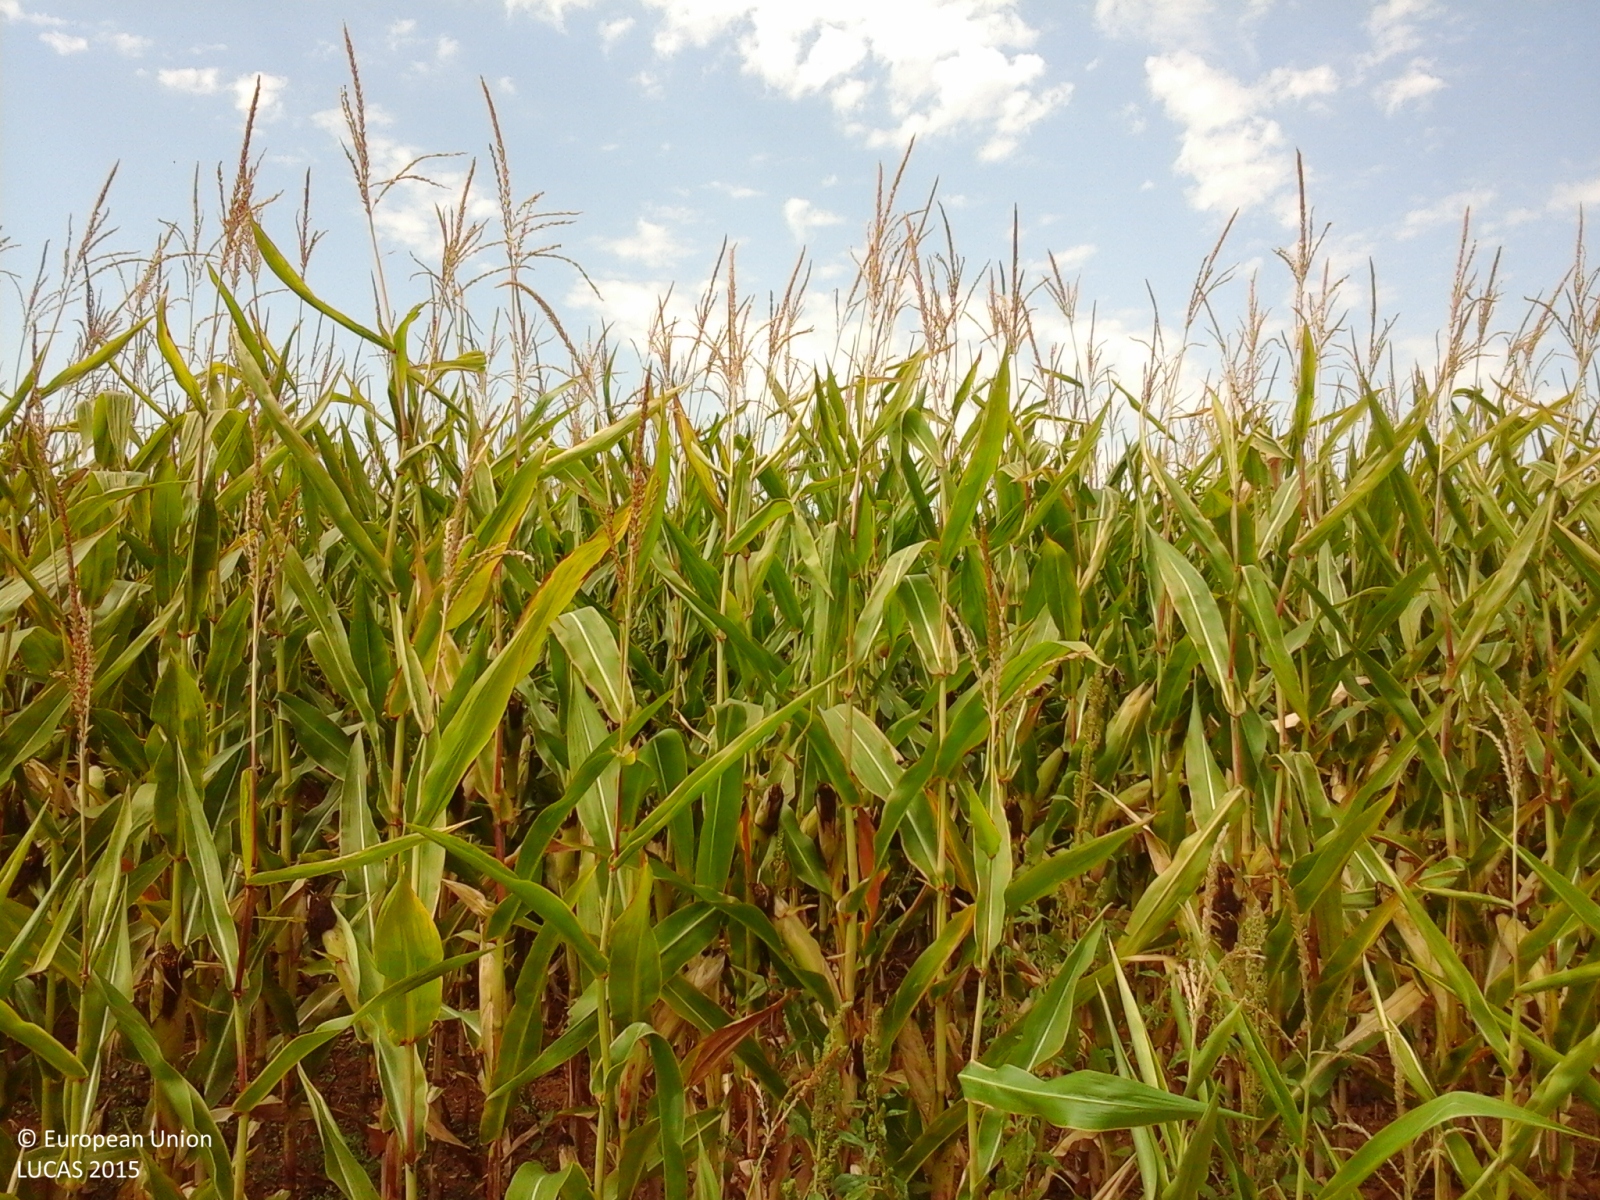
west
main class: Cropland
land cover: Maize
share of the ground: > 75 %
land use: Agriculture (excluding fallow land and kitchen gardens)
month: August
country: IT
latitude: 42.7022
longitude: 11.1072
